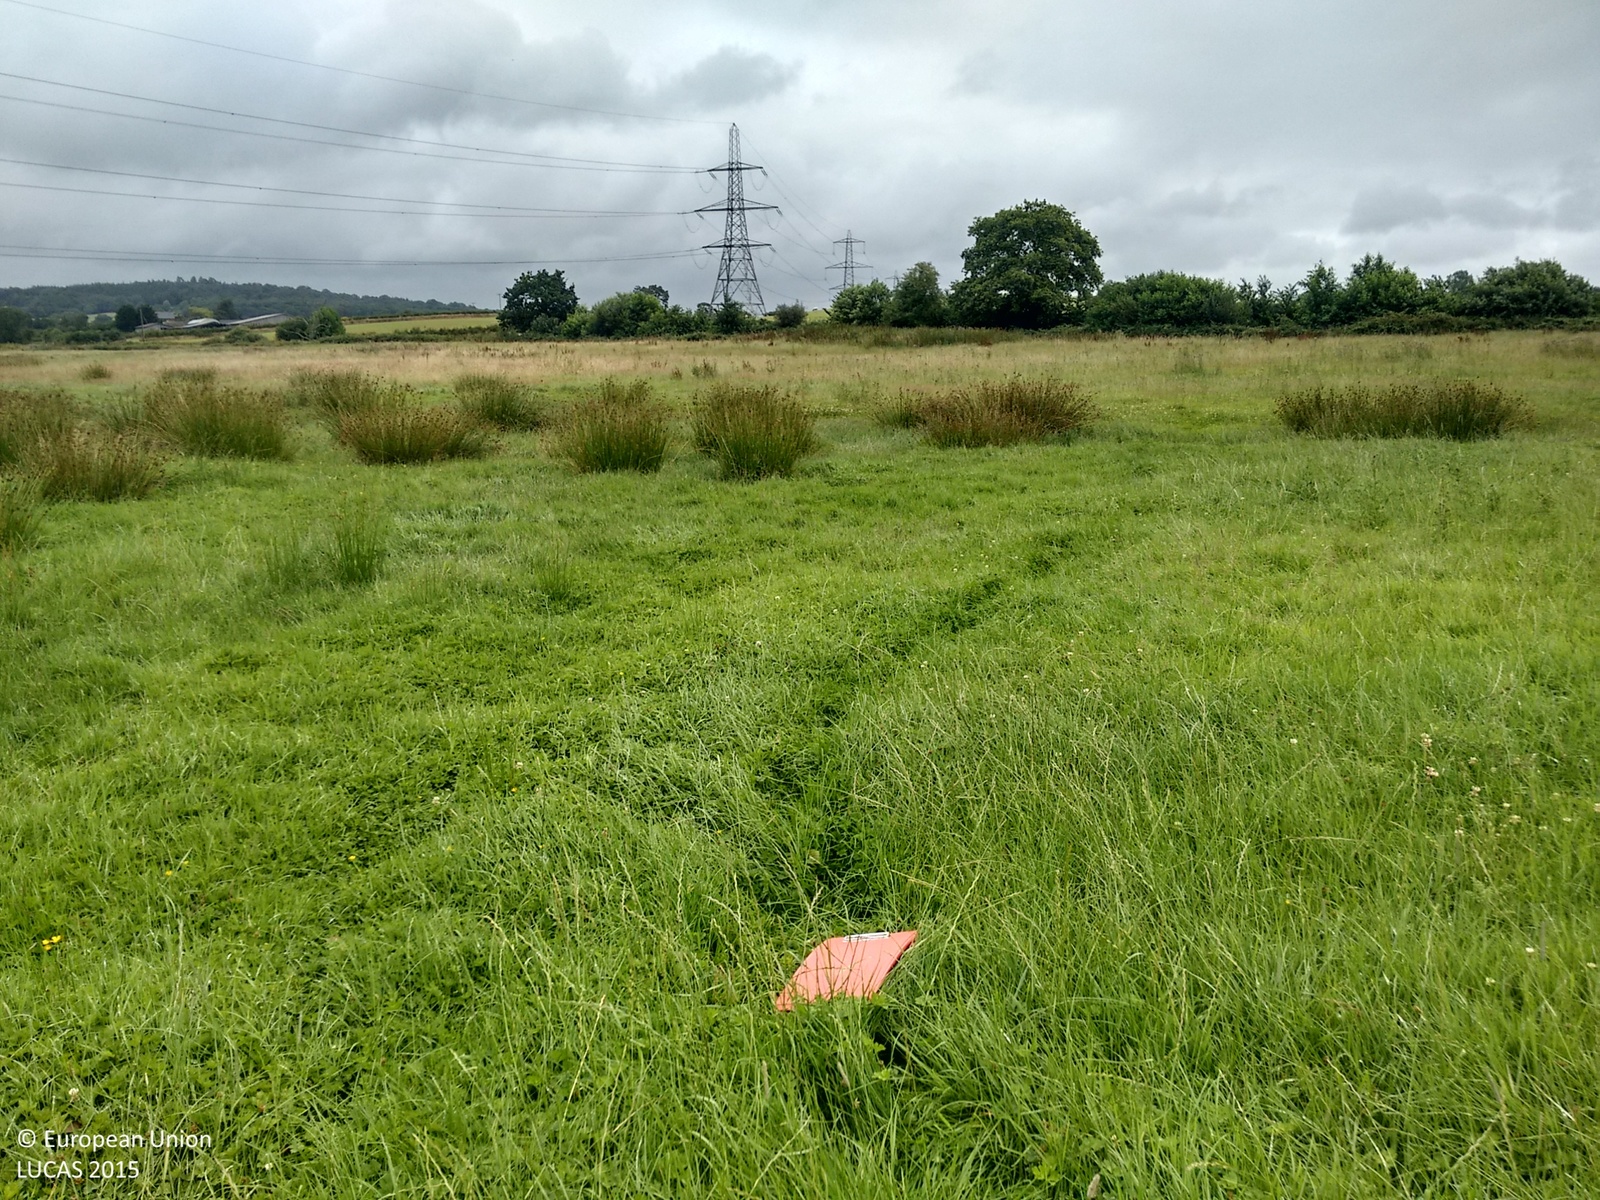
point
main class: Grassland
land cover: Grassland without tree/shrub cover
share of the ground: > 75 %
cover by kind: herbaceous plants 100 %
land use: Agriculture (excluding fallow land and kitchen gardens)
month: July
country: GB
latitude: 50.7681
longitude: -3.4539
